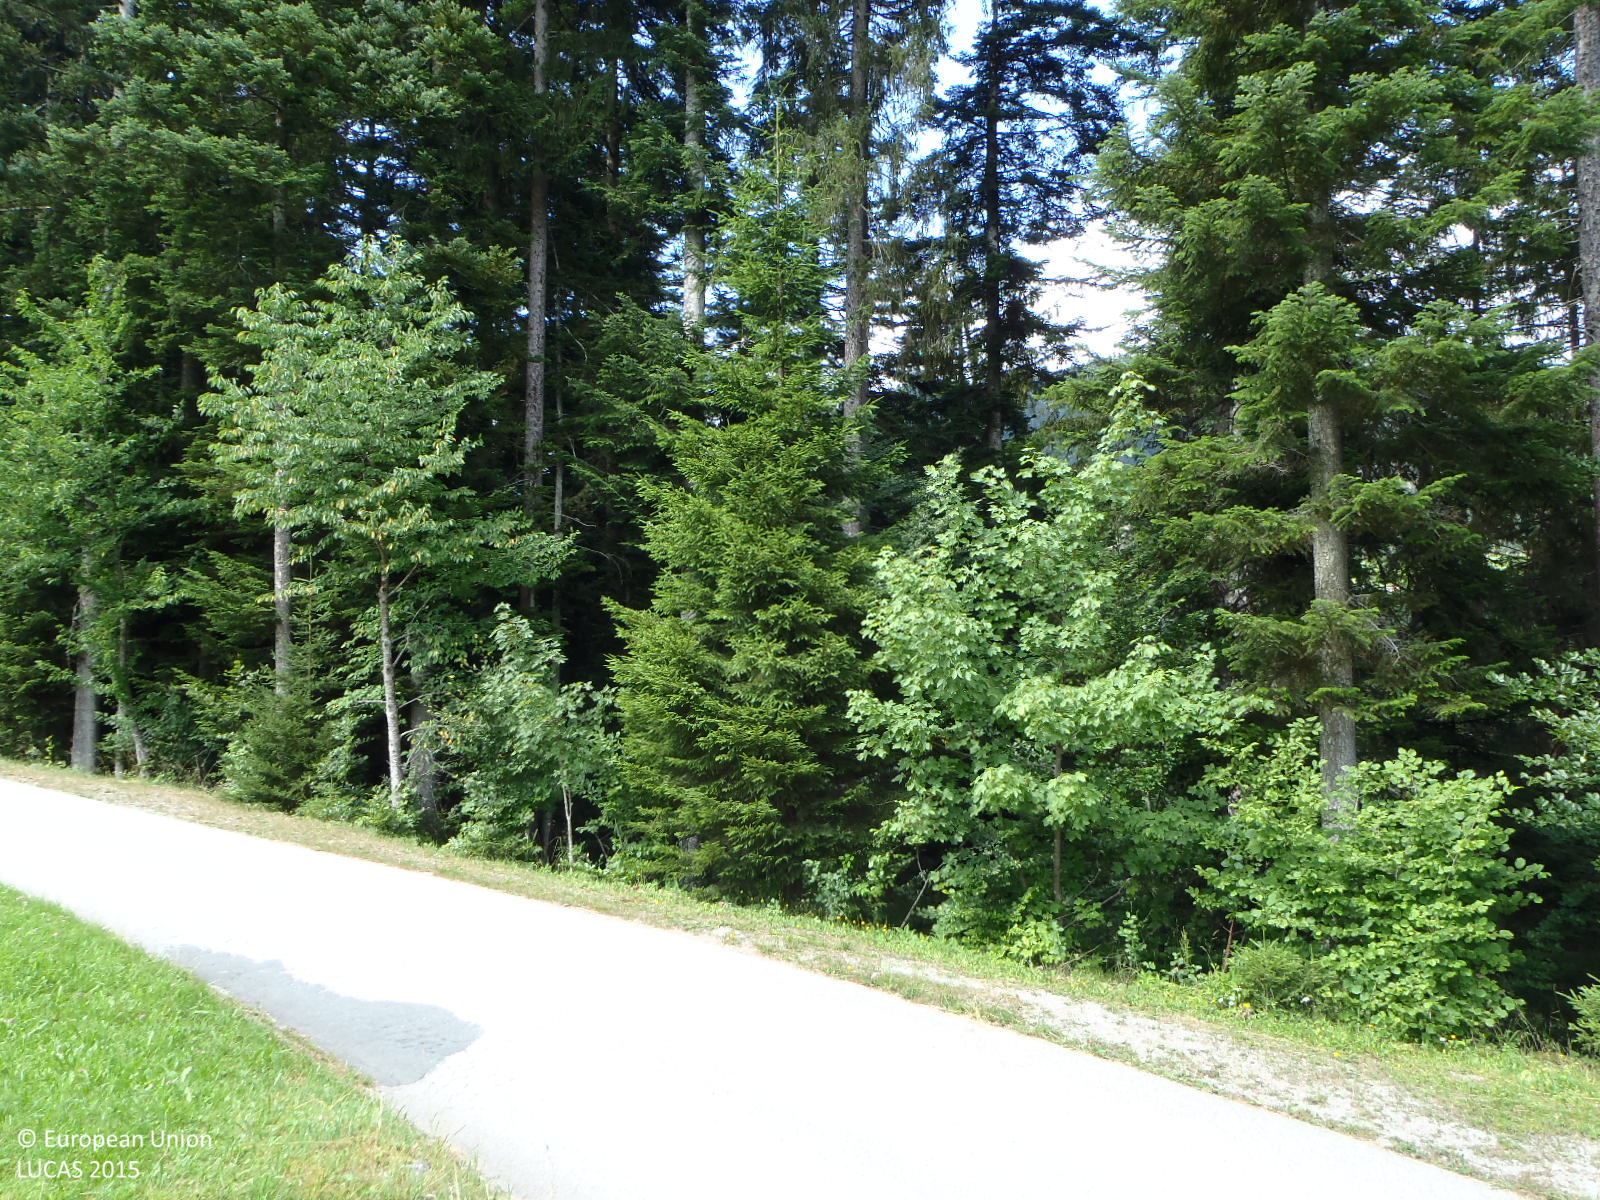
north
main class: Grassland
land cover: Grassland without tree/shrub cover
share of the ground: > 75 %
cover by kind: herbaceous plants 100 %
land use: Agriculture (excluding fallow land and kitchen gardens)
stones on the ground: < 10 %
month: July
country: AT
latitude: 47.5177
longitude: 12.1896
